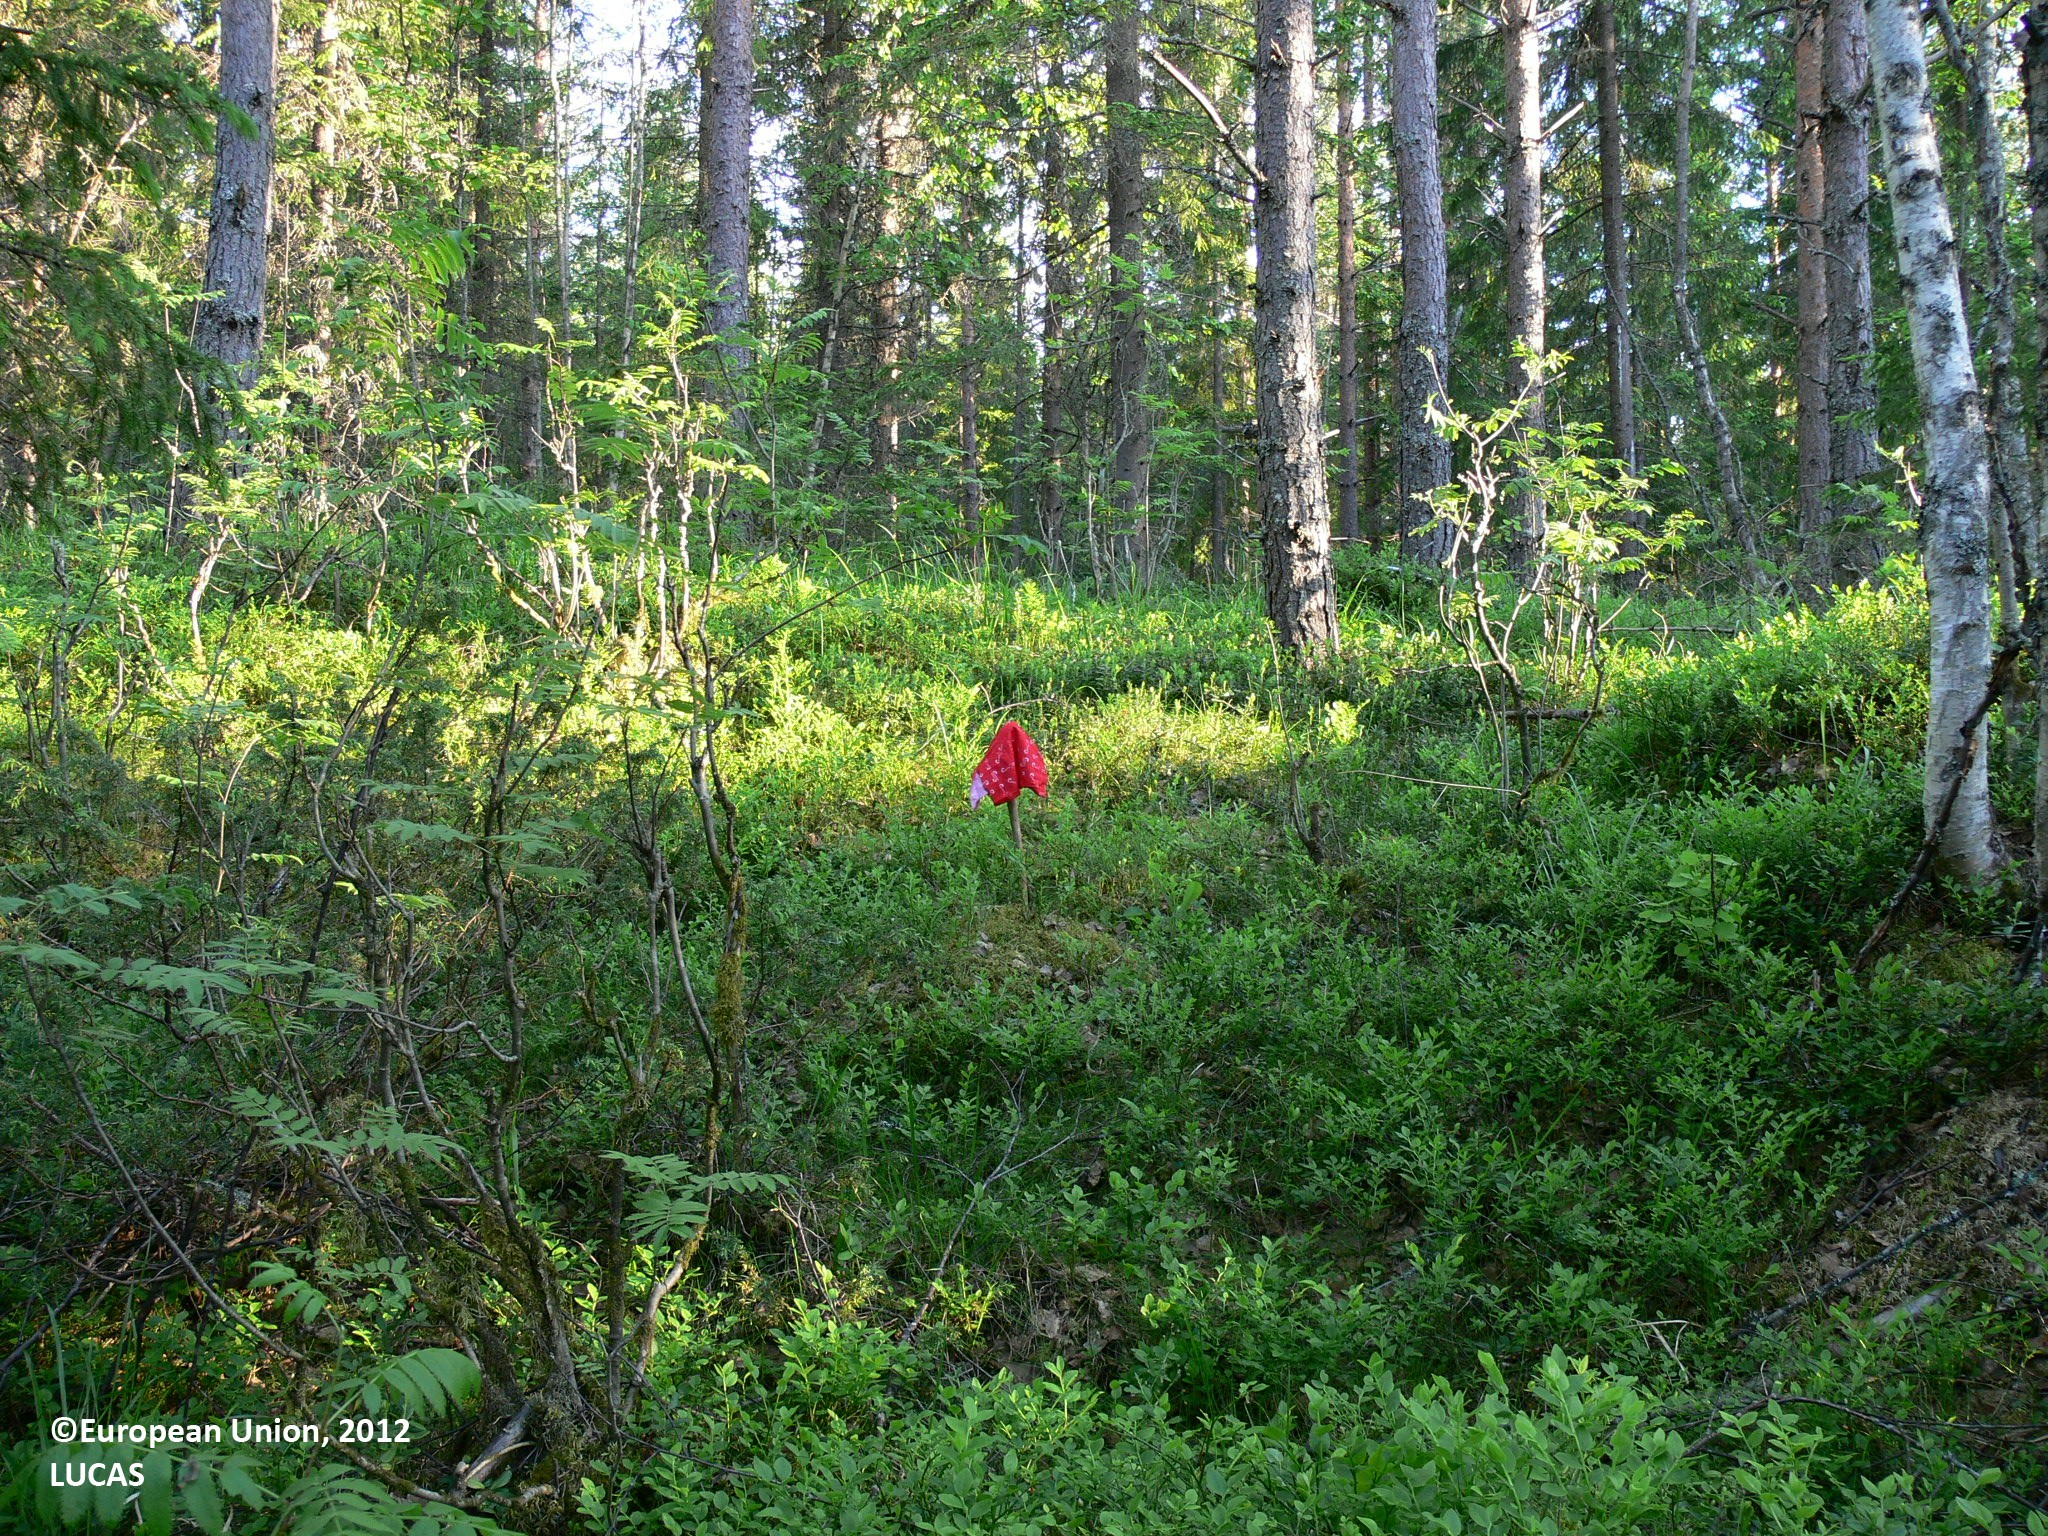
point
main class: Woodland
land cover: Other mixed woodland
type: boreal forest
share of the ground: > 75 %
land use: Forestry
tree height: > 5 m
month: June
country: FI
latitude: 62.2882
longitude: 30.5867
